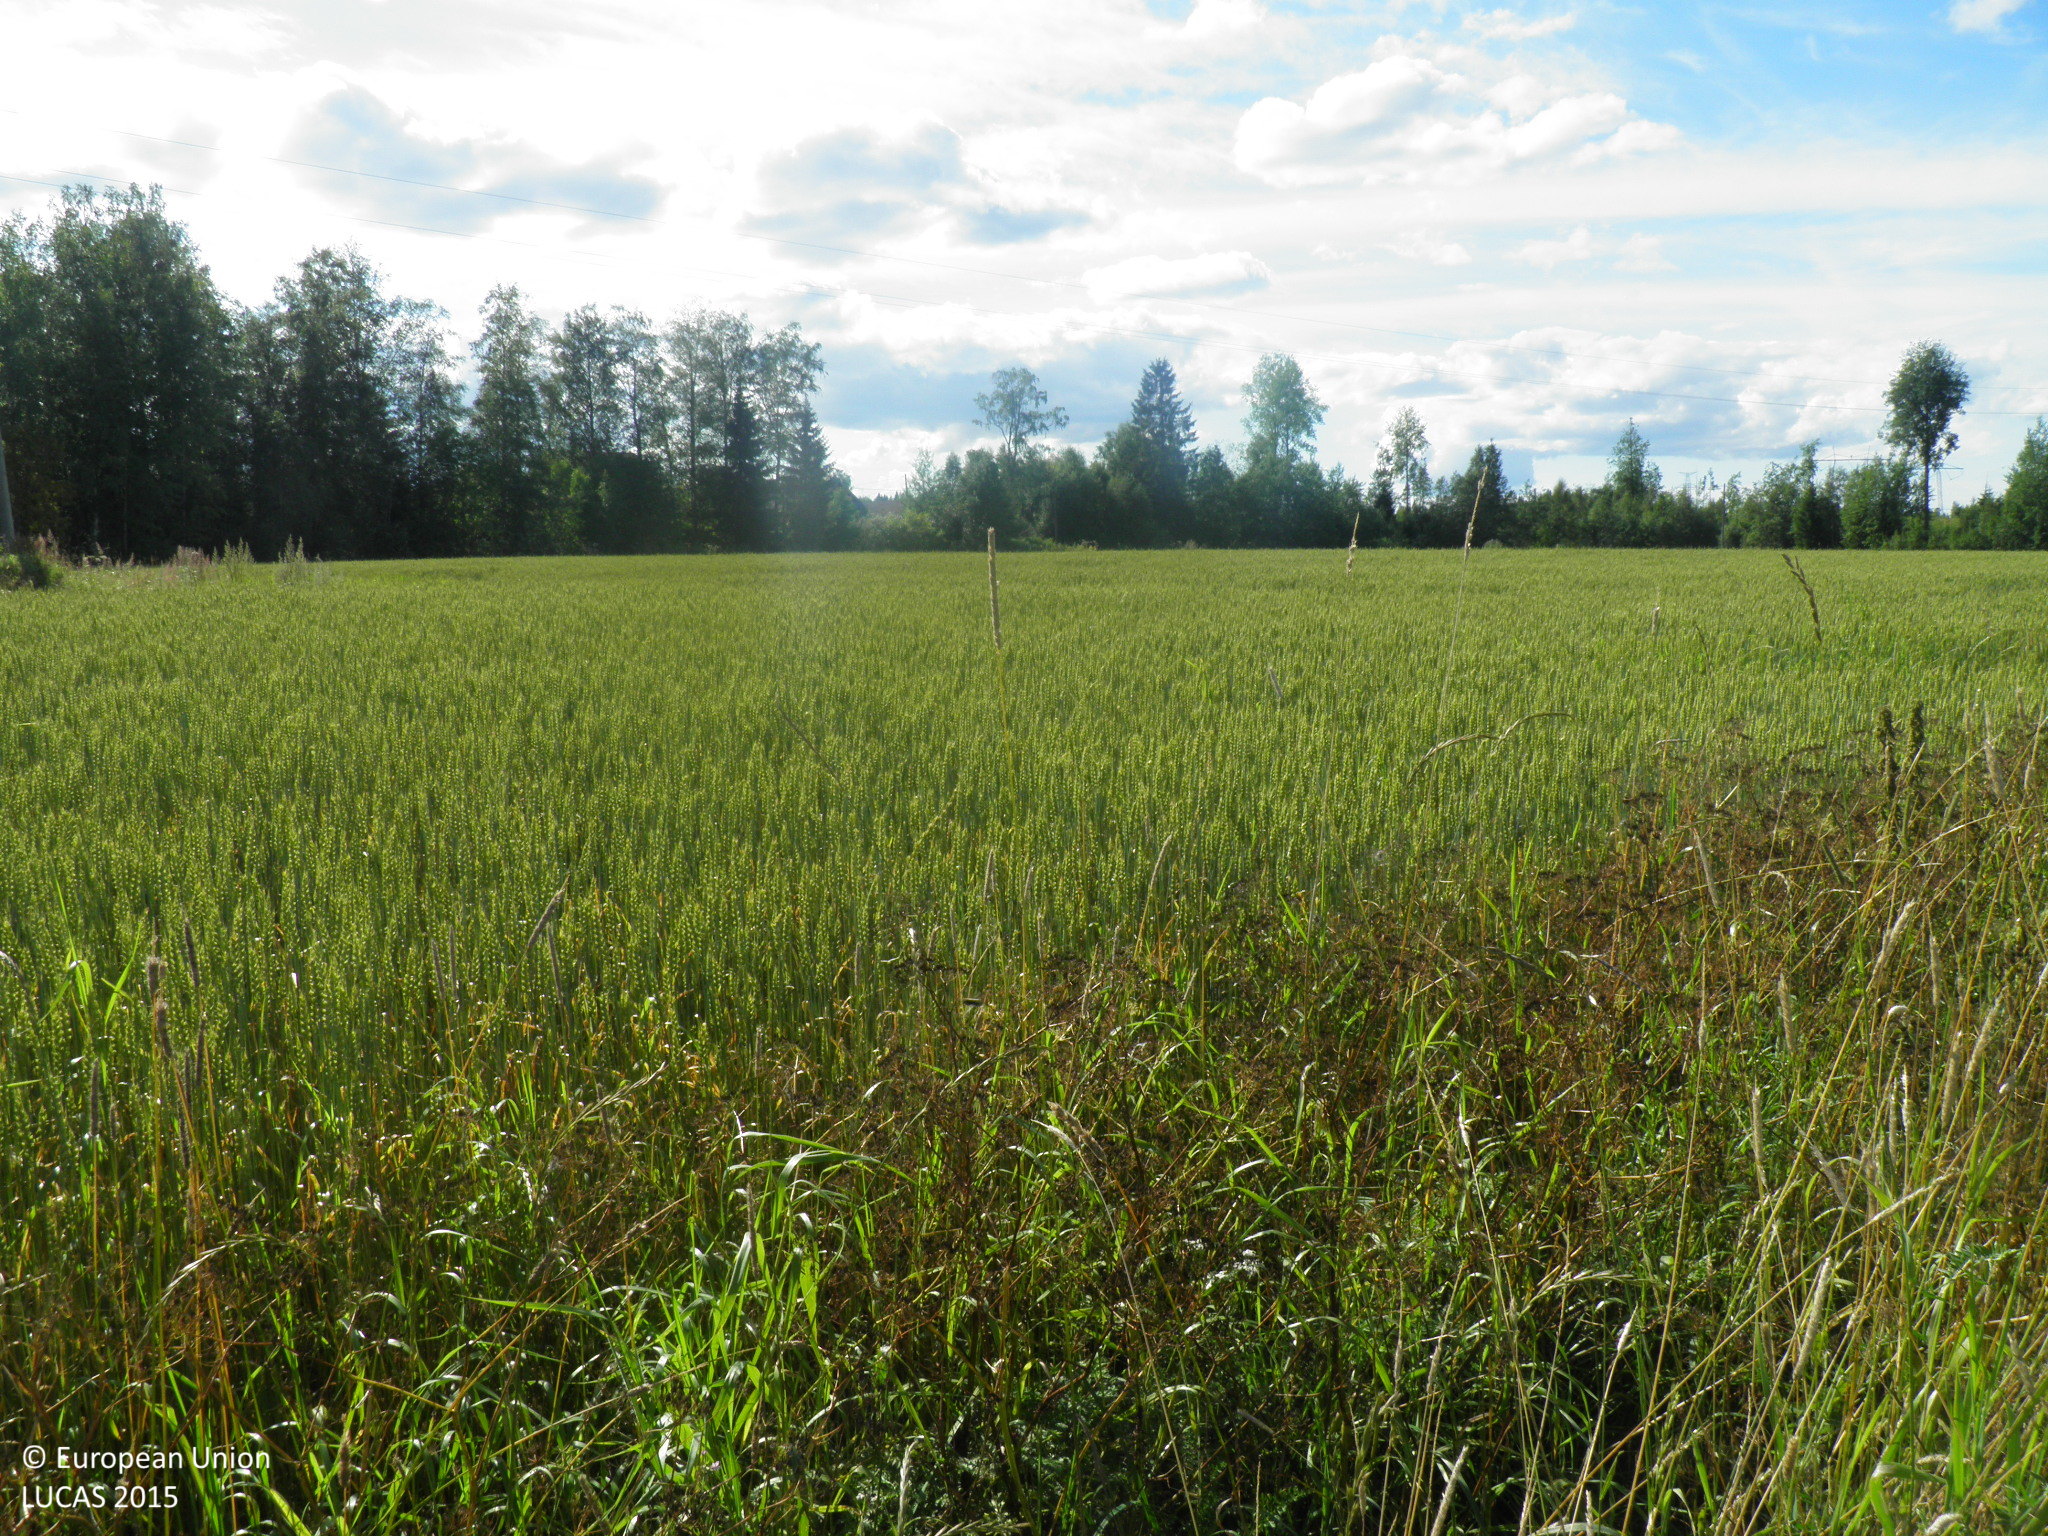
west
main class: Cropland
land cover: Oats
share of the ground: > 75 %
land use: Agriculture (excluding fallow land and kitchen gardens)
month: August
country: FI
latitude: 61.1471
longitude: 22.6068
